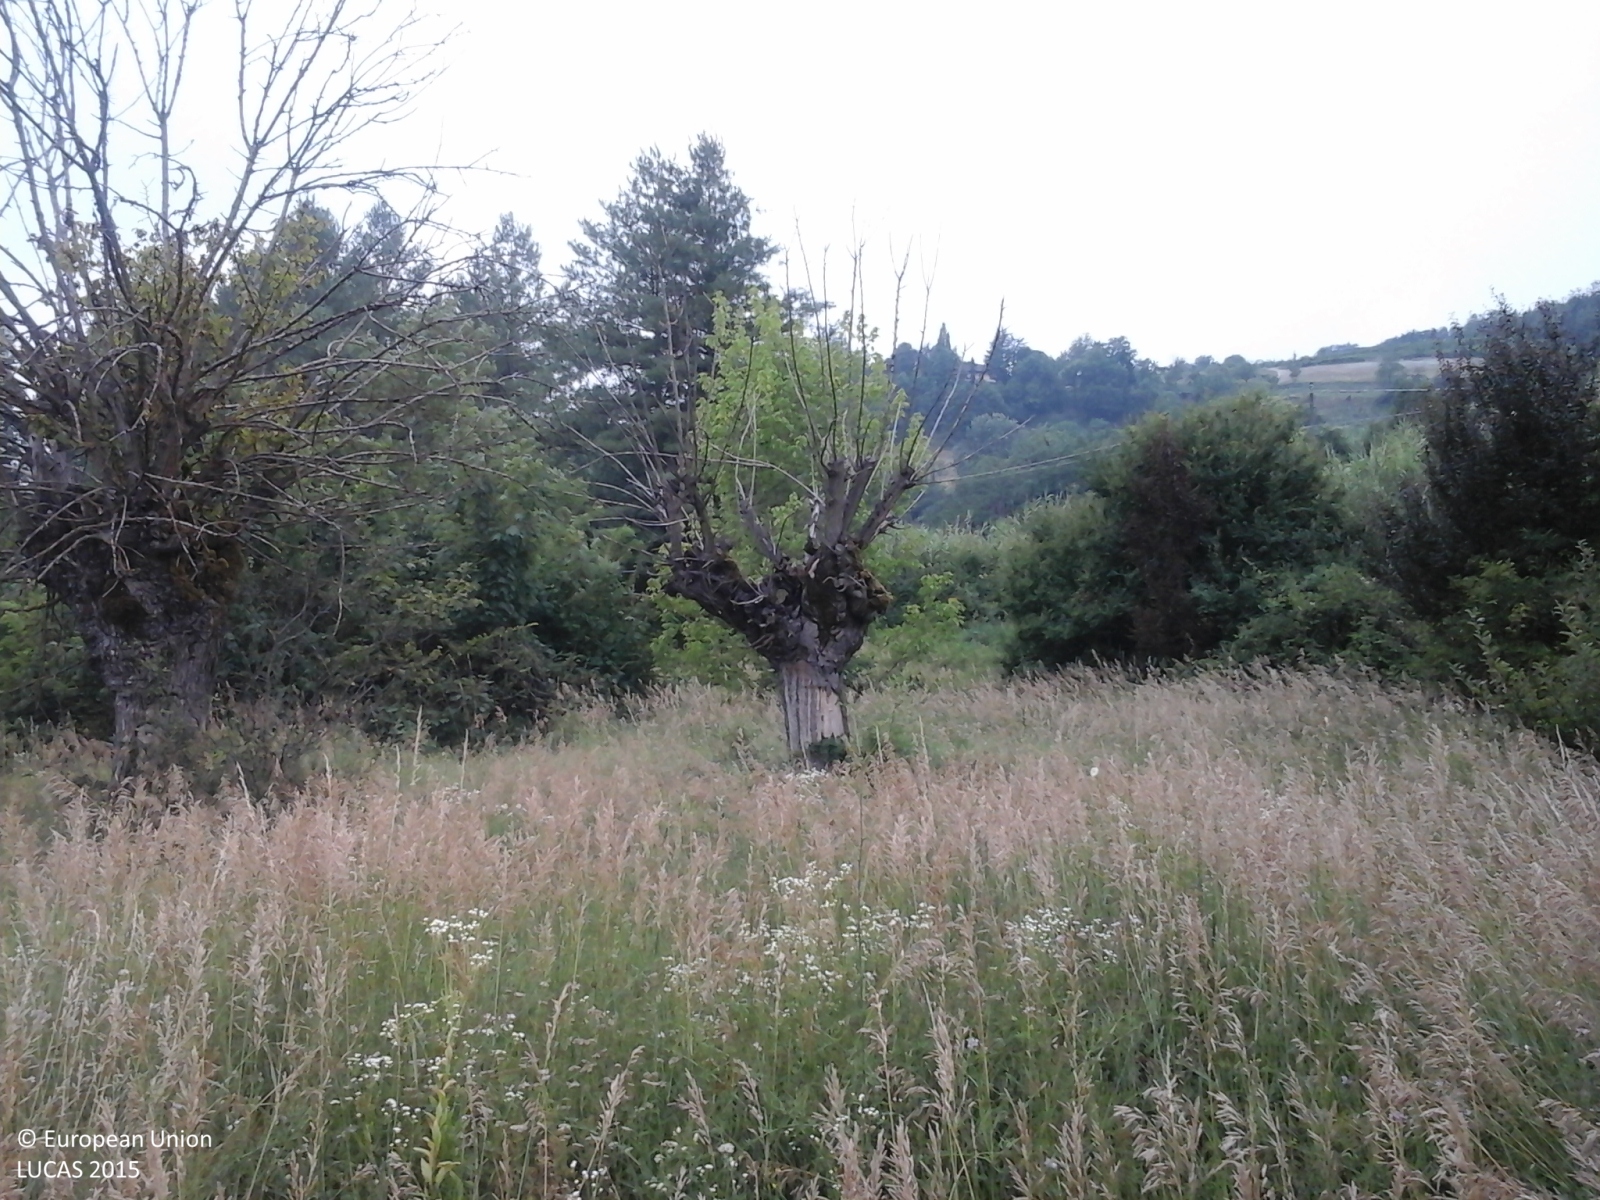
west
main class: Grassland
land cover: Grassland without tree/shrub cover
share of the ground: > 75 %
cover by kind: herbaceous plants 100 %
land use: Agriculture (excluding fallow land and kitchen gardens)
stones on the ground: < 10 %
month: July
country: IT
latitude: 44.6817
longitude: 8.4514
